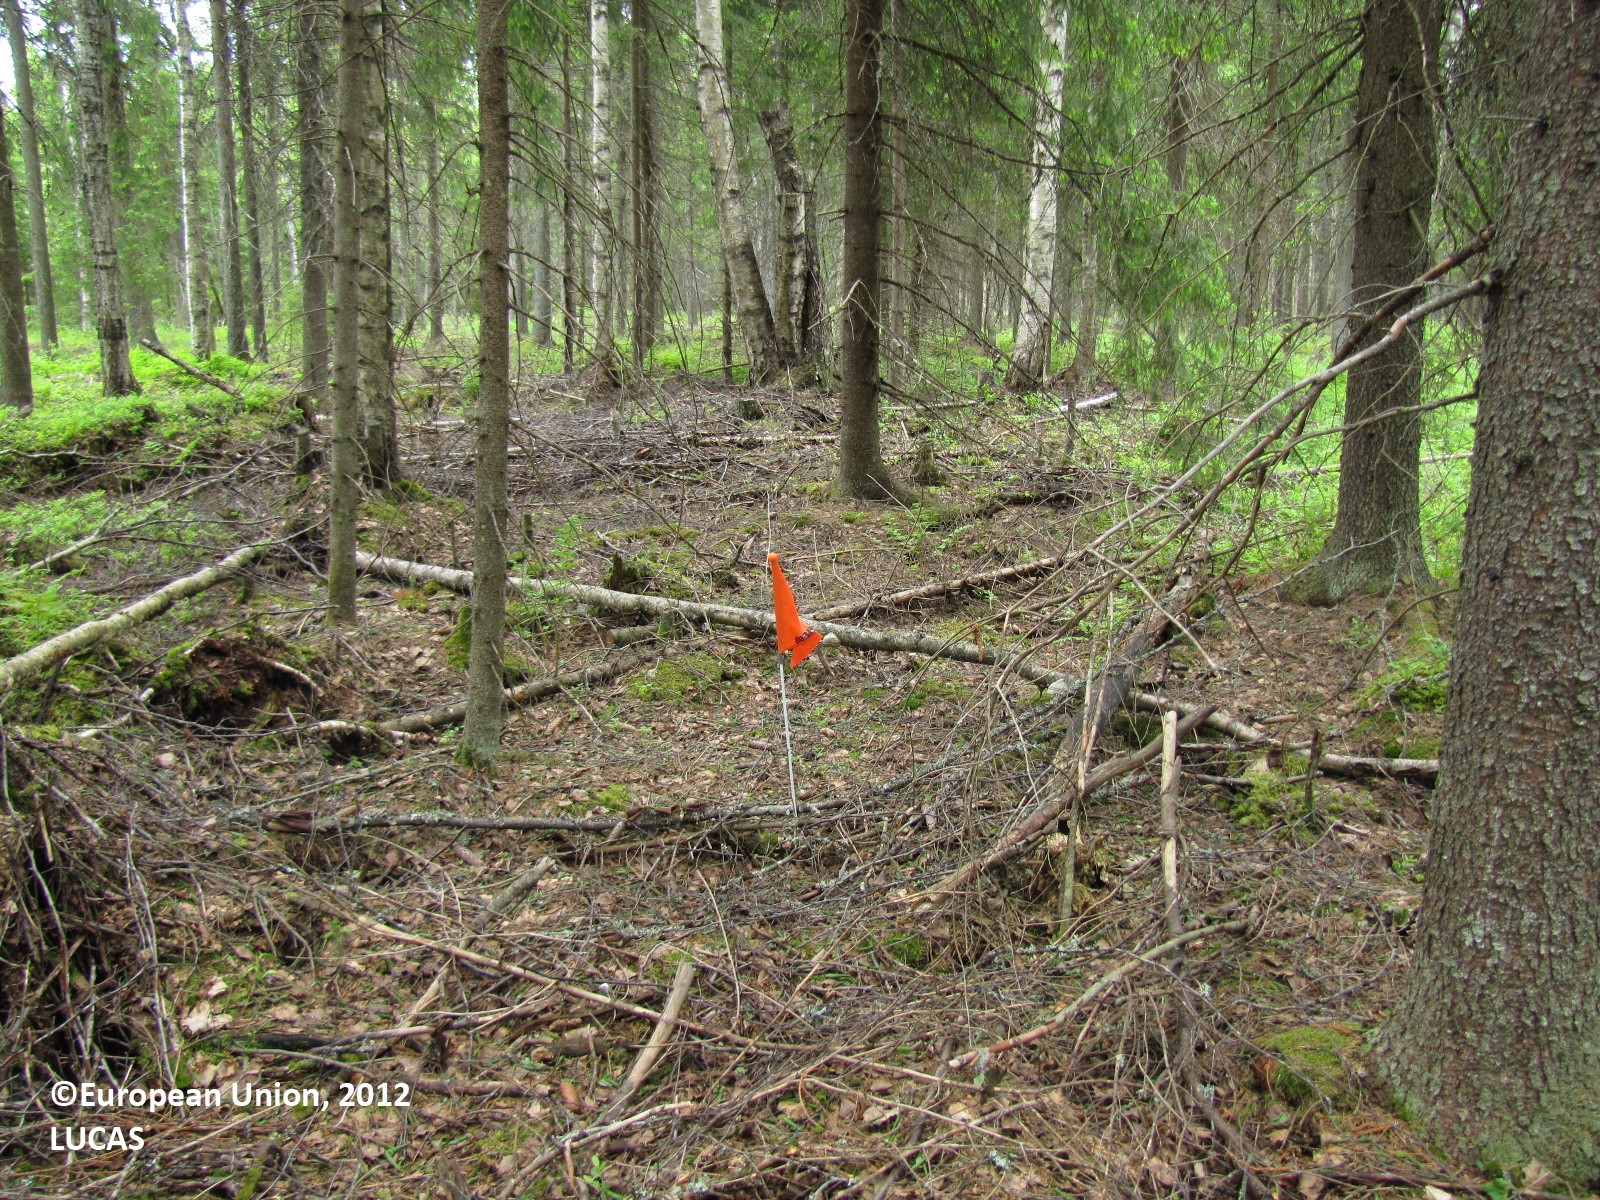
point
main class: Woodland
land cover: Spruce dominated mixed woodland
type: hemiboreal forest and nemoral coniferous forest and mixed broadleaved-coniferous forest
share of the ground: 50 - 75 %
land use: Forestry
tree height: > 5 m
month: June
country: FI
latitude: 61.2366
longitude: 23.4377
